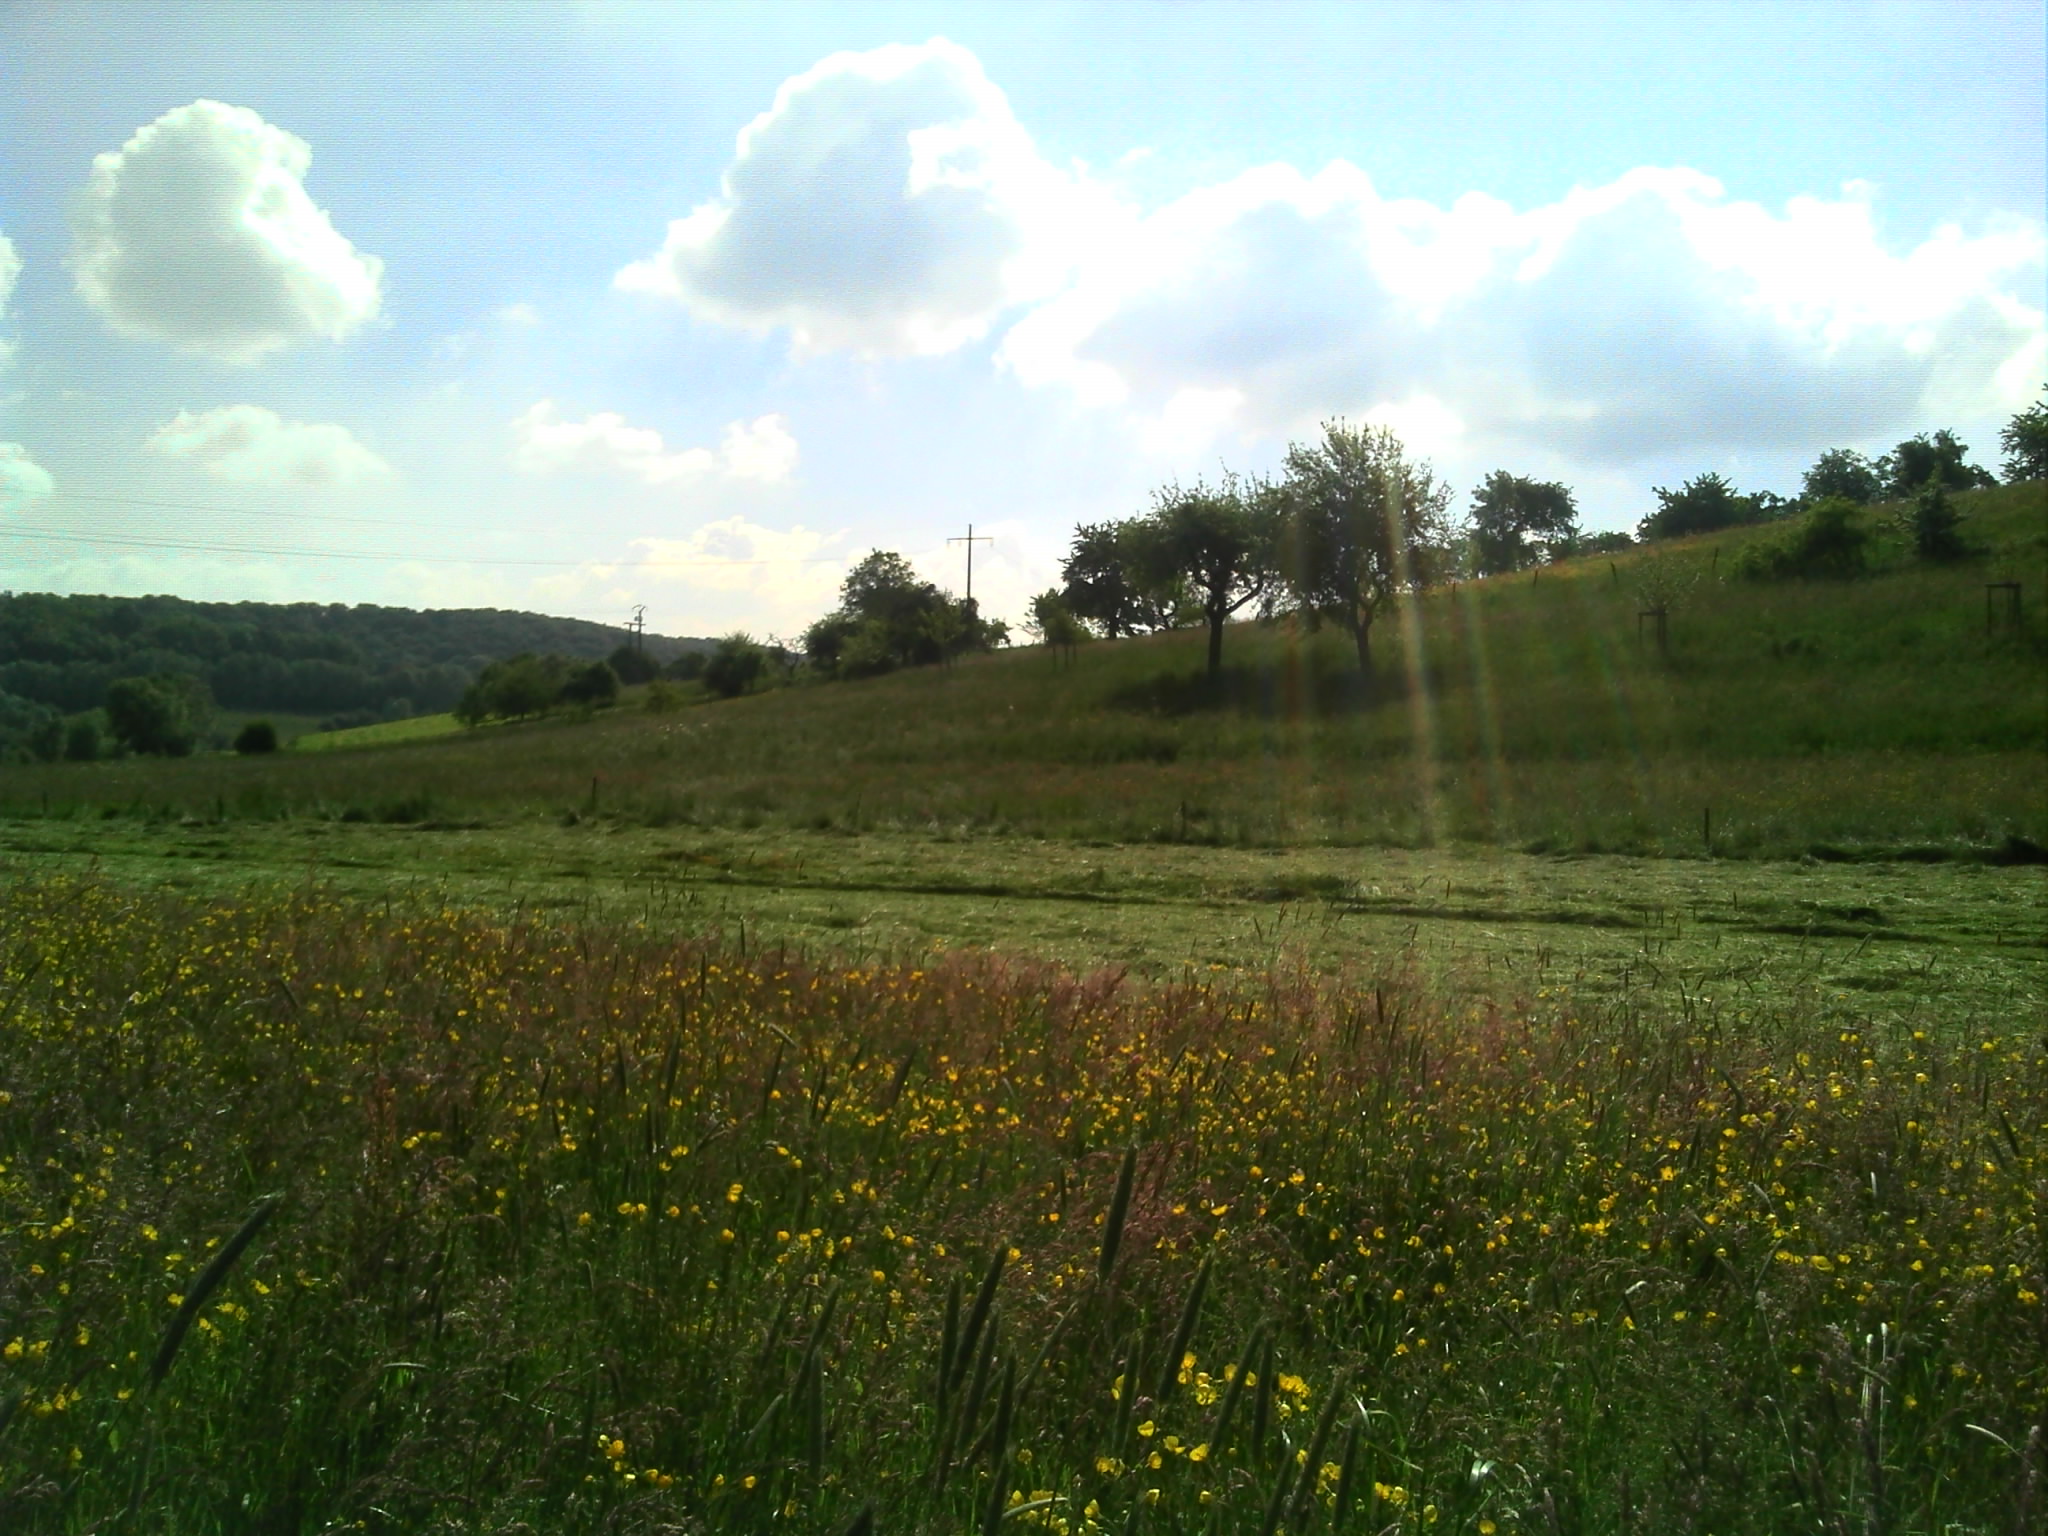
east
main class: Grassland
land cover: Grassland without tree/shrub cover
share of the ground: > 75 %
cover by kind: herbaceous plants 100 %
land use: Agriculture (excluding fallow land and kitchen gardens)
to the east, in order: Grassland without tree/shrub cover; Grassland with sparse tree/shrub cover; Fences; Grassland with sparse tree/shrub cover; Fences; Grassland with sparse tree/shrub cover; Electric lines; Grassland with sparse tree/shrub cover; Fences; Grass margins; Paved roads, cycling and walking lanes; Grass margins; Grassland with sparse tree/shrub cover
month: May
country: LU
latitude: 49.5655
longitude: 6.2803
